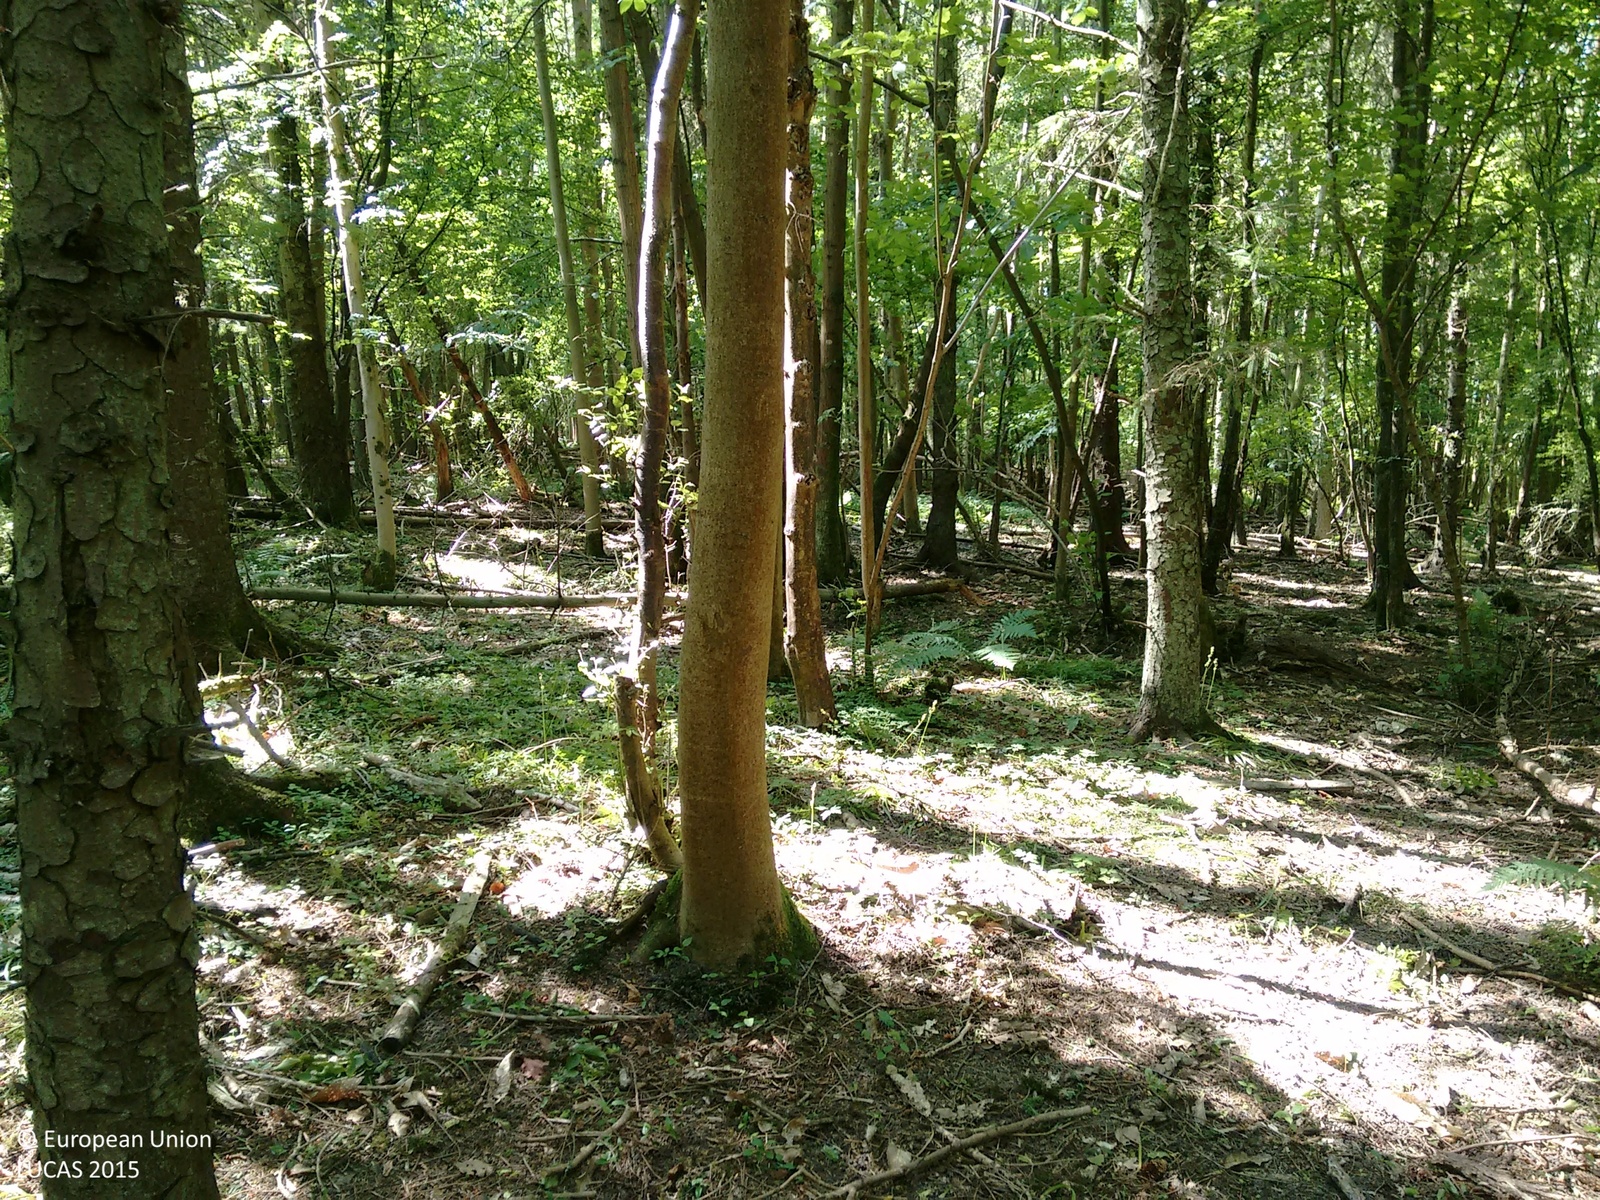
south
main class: Woodland
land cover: Other mixed woodland
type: exotic forest
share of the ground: > 75 %
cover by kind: coniferous forest trees 50 %, broadleaved forest trees 50 %
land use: Forestry
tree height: > 5 m
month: June
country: GB
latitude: 50.9818
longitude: 0.4998
